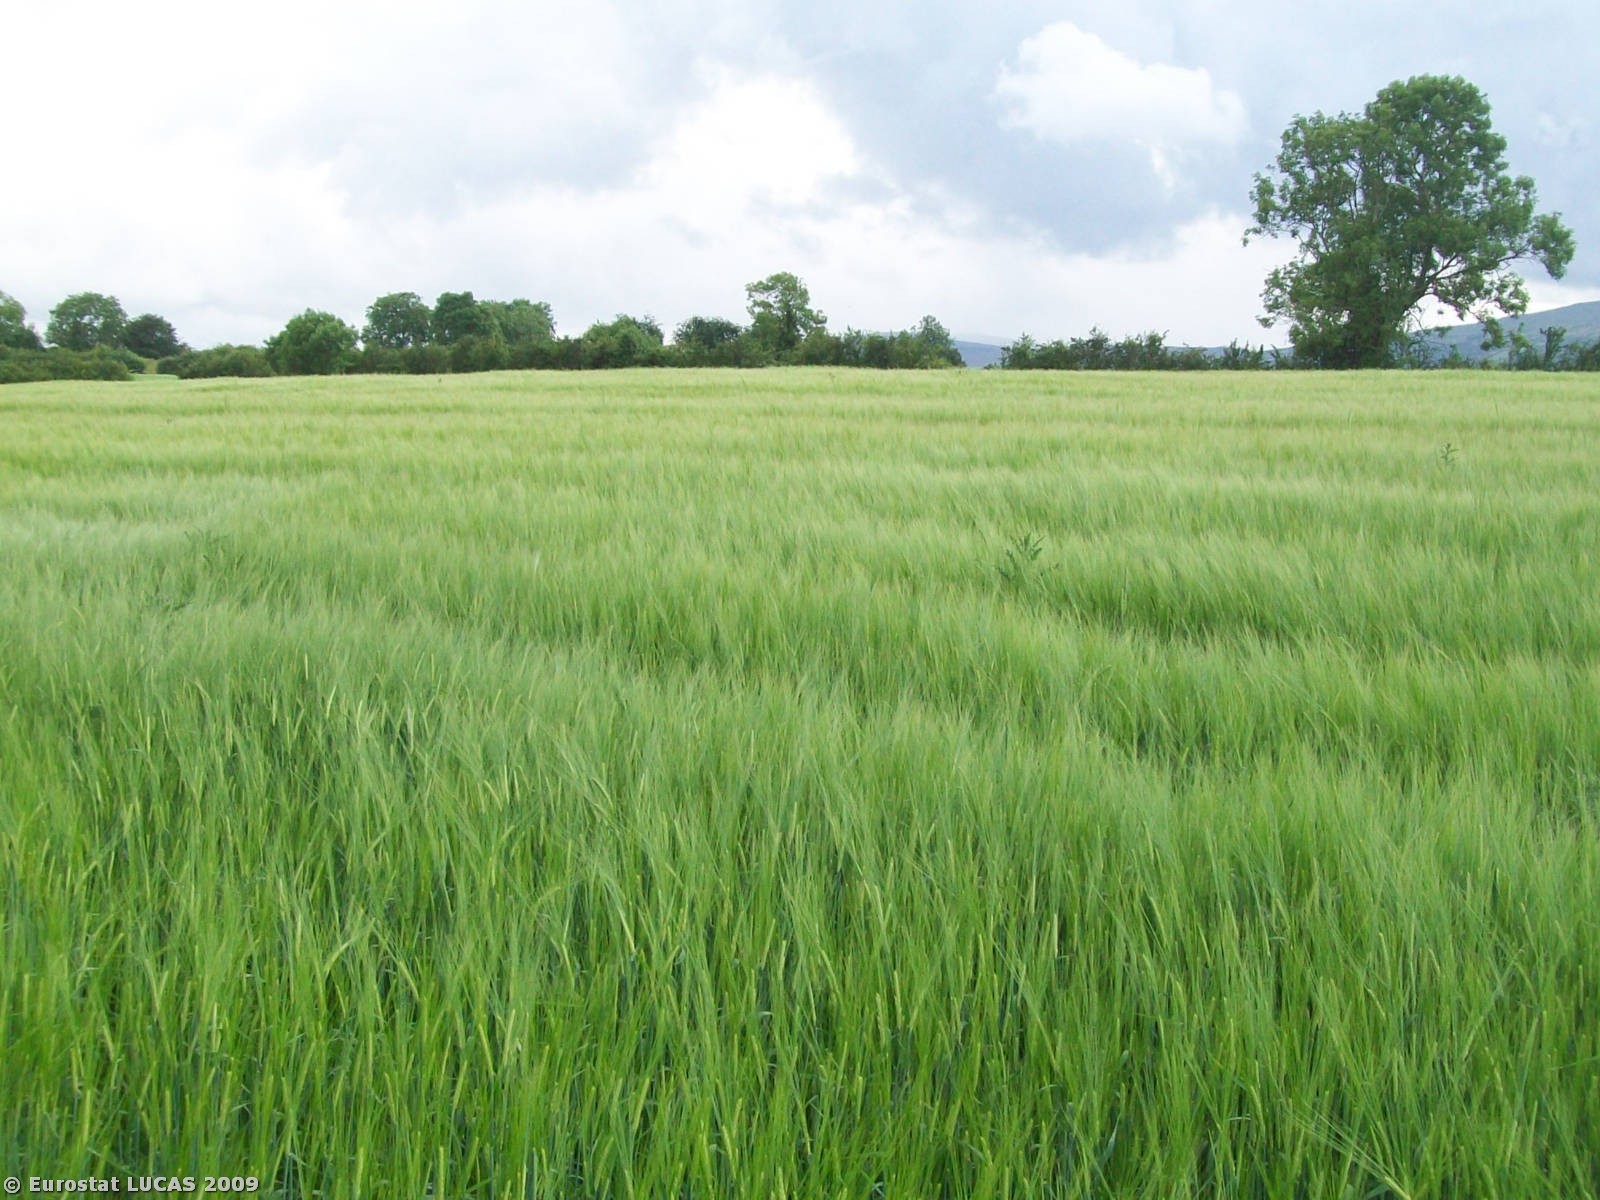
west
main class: Cropland
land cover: Barley
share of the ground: > 75 %
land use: Agriculture (excluding fallow land and kitchen gardens)
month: July
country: GB
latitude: 54.7931
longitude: -6.7893
